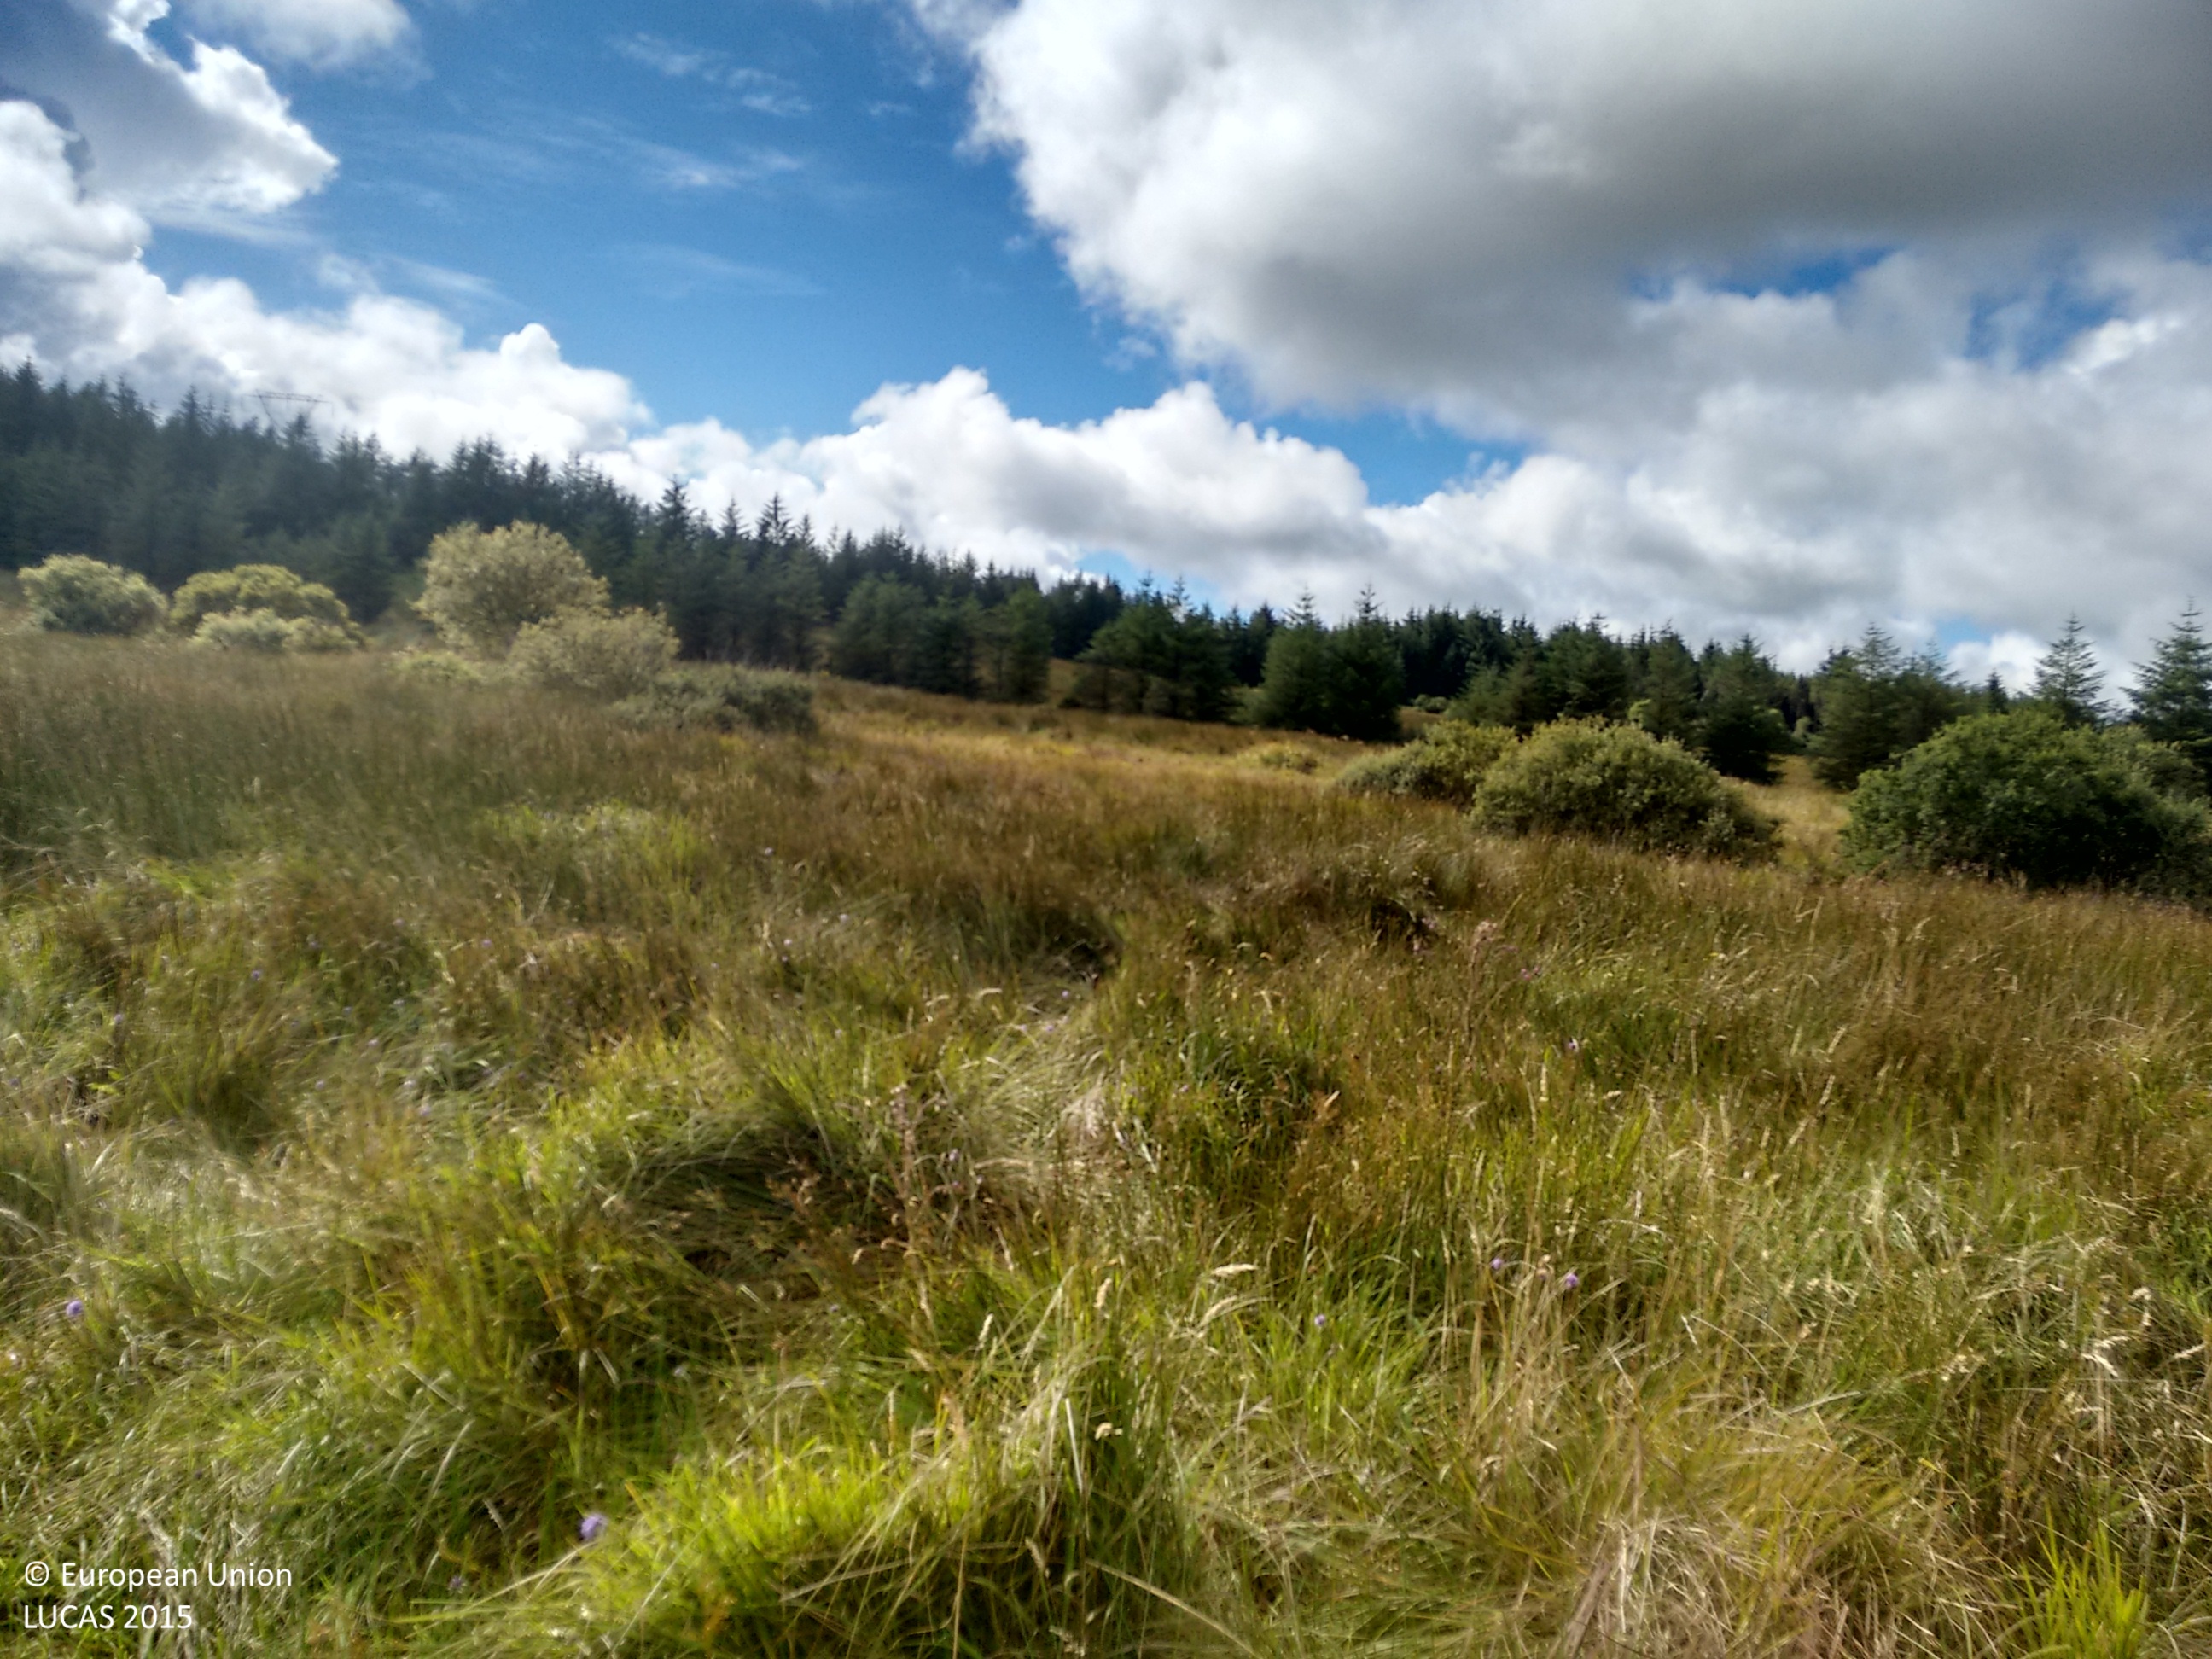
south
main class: Grassland
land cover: Grassland without tree/shrub cover
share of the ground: > 75 %
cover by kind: herbaceous plants 95 %, shrubs 5 %
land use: Agriculture (excluding fallow land and kitchen gardens)
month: September
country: IE
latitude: 52.2755
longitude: -9.3839
